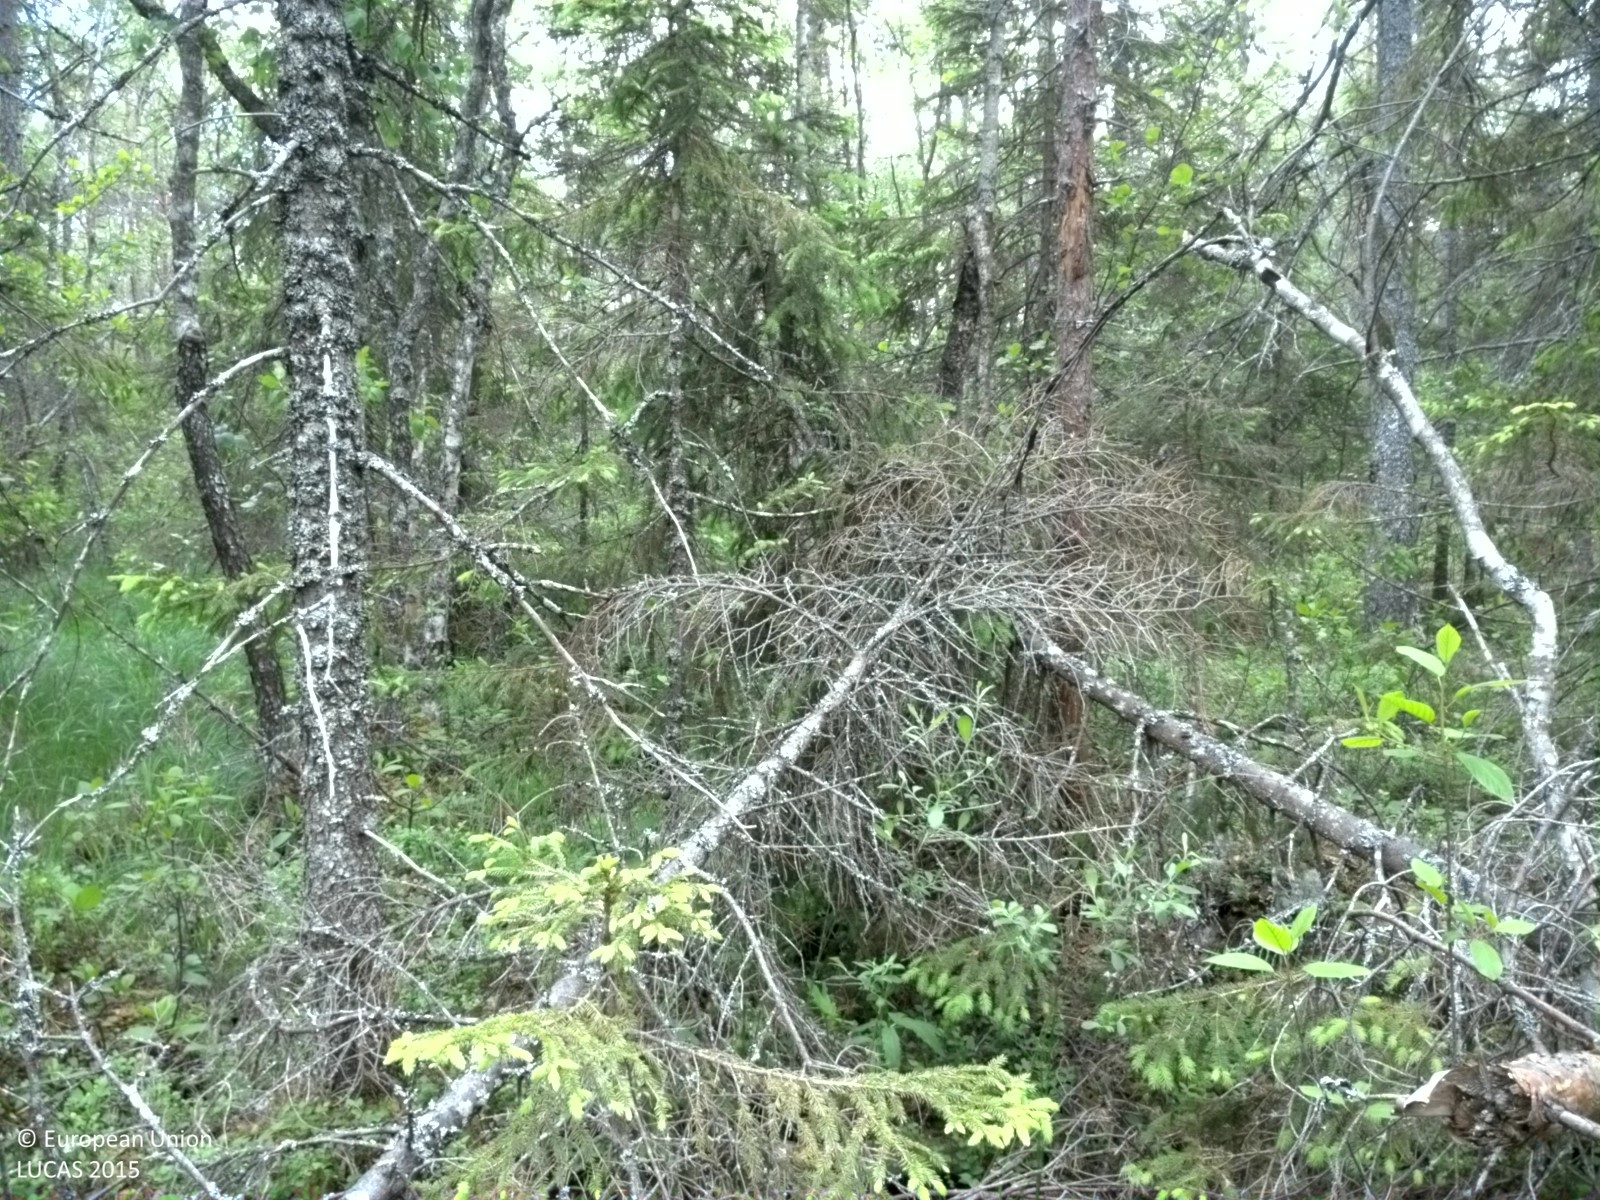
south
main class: Woodland
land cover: Other mixed woodland
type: boreal forest
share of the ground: 50 - 75 %
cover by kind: broadleaved forest trees 35 %, herbaceous plants 30 %, coniferous forest trees 25 %, lichens and mosses 5 %, consolidated bare surface 5 %
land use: Semi-natural and natural areas not in use
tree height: > 5 m
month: June
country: SE
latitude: 60.2692
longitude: 17.8569
